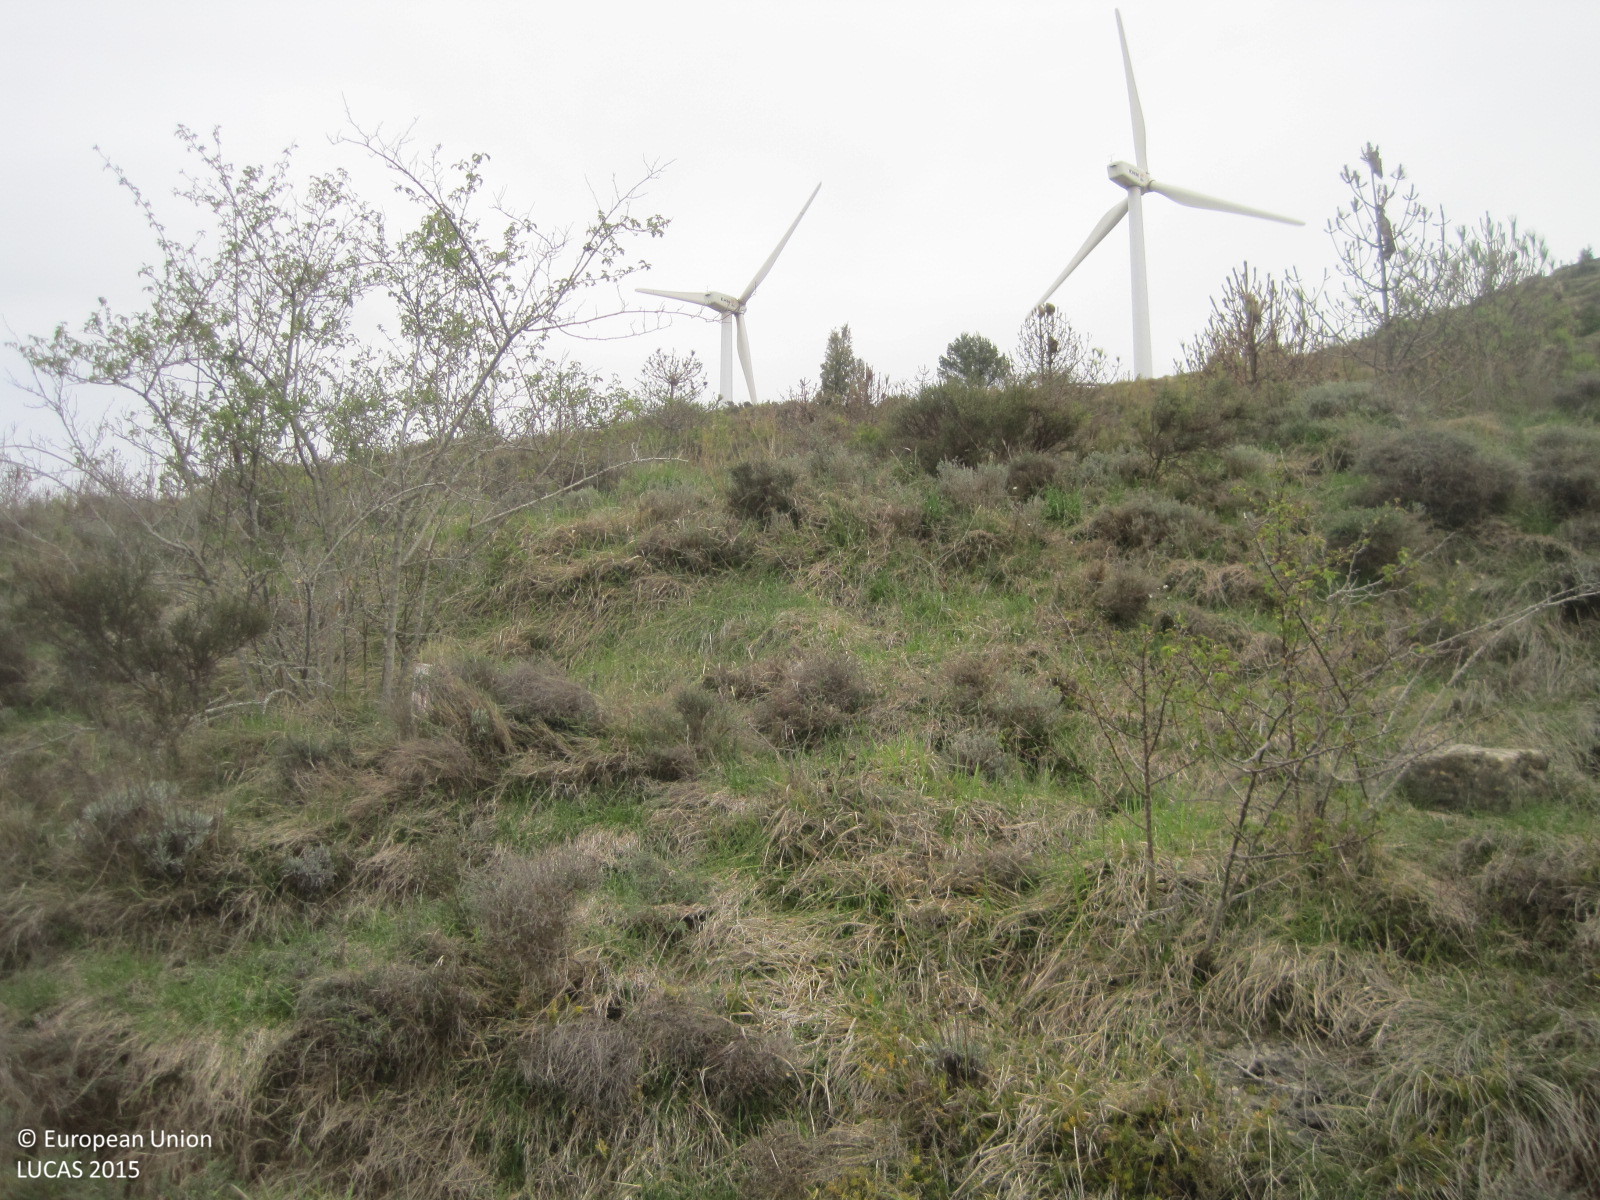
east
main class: Shrubland
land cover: Shrubland without tree cover
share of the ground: > 75 %
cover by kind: herbaceous plants 75 %, shrubs 25 %
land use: Forestry
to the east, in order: Shrubland without tree cover; Pine dominated coniferous woodland; Shrubland without tree cover; Grassland with sparse tree/shrub cover; Tracks; Pine dominated coniferous woodland
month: April
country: ES
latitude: 42.6015
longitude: -2.3922
